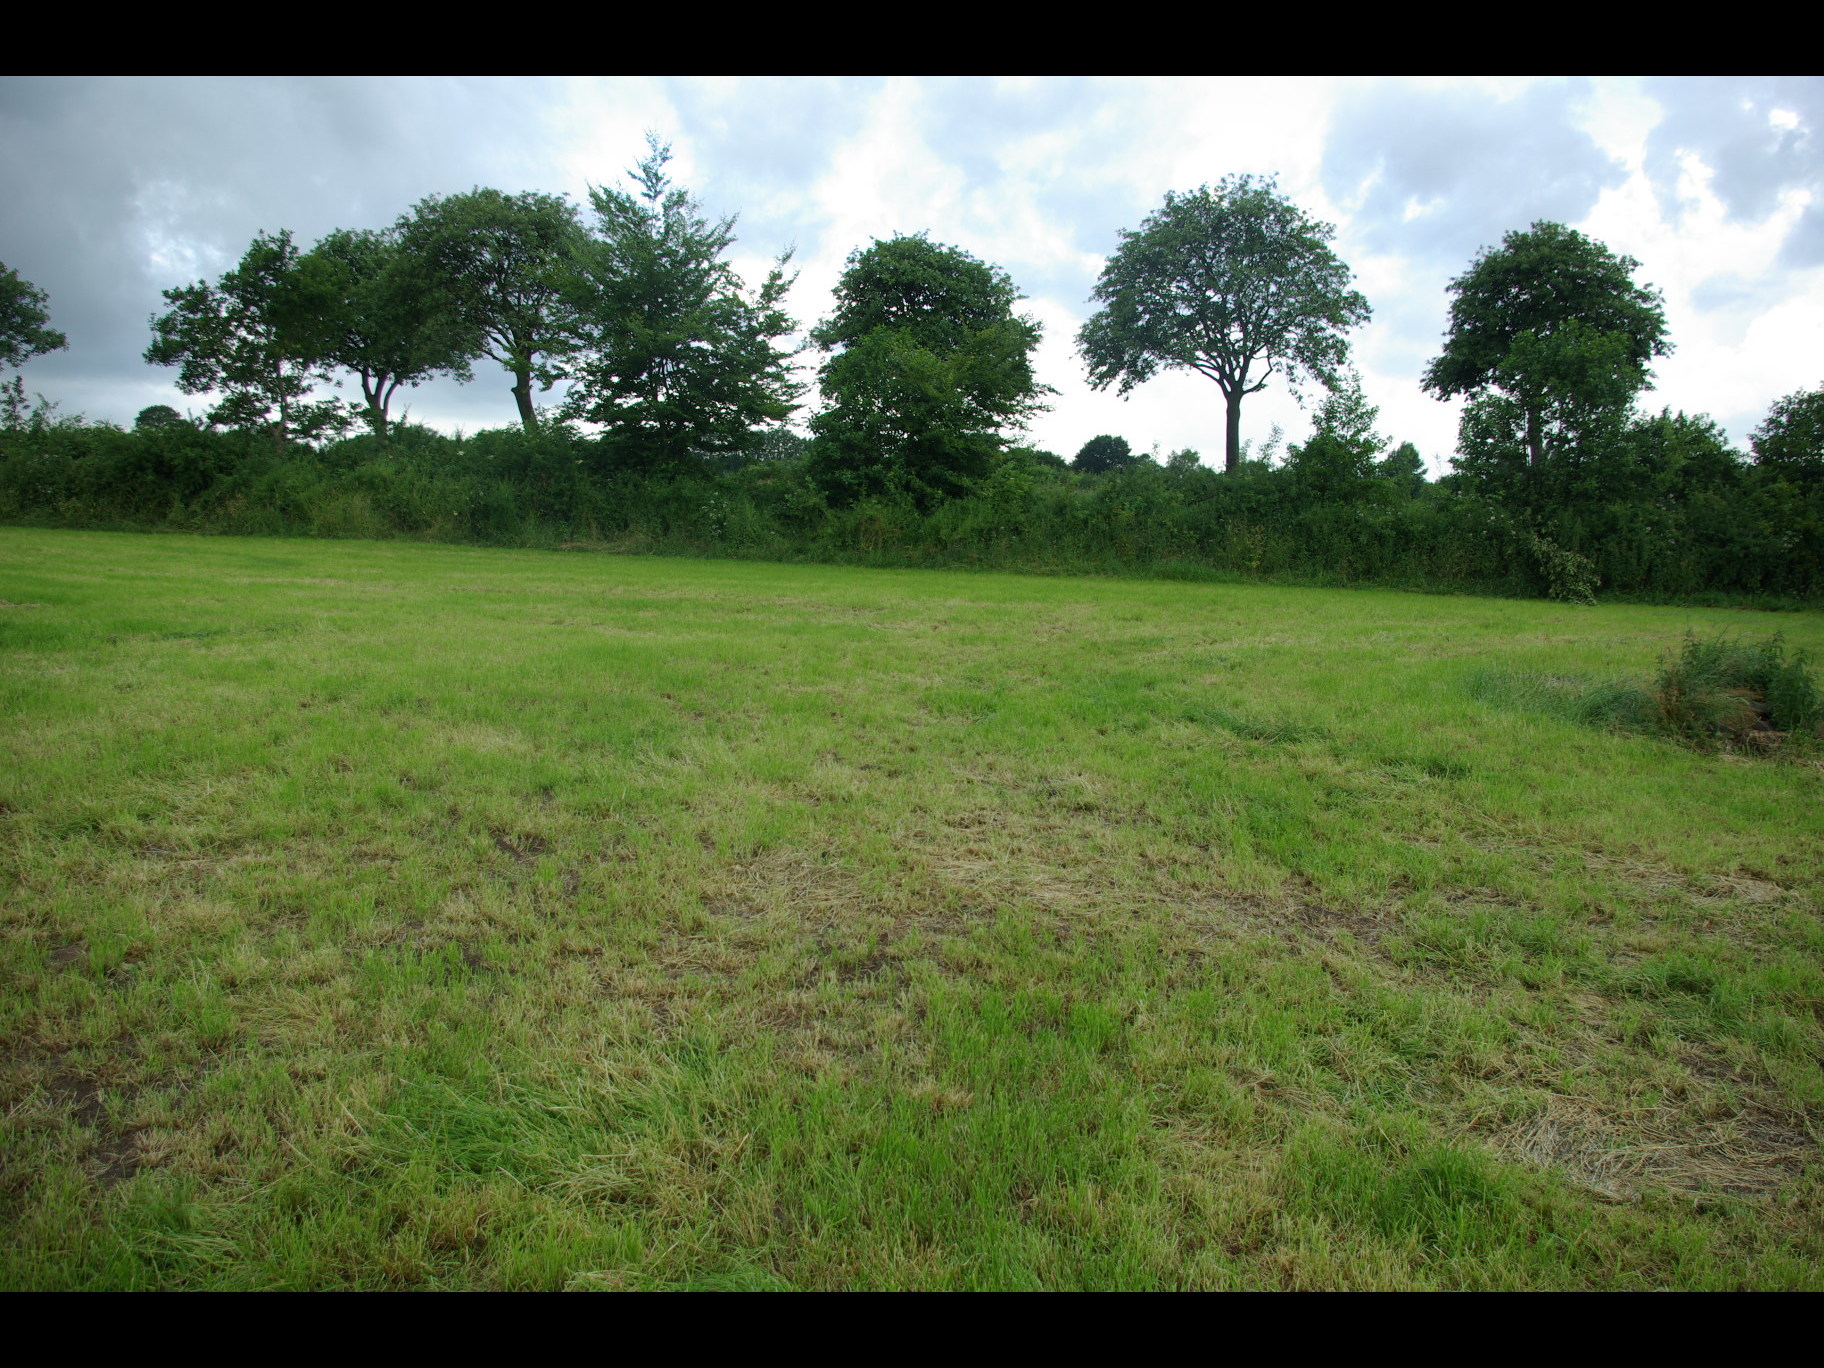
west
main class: Grassland
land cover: Grassland without tree/shrub cover
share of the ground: > 75 %
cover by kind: herbaceous plants 100 %
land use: Agriculture (excluding fallow land and kitchen gardens)
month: July
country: DE
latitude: 54.1380
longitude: 9.5564
